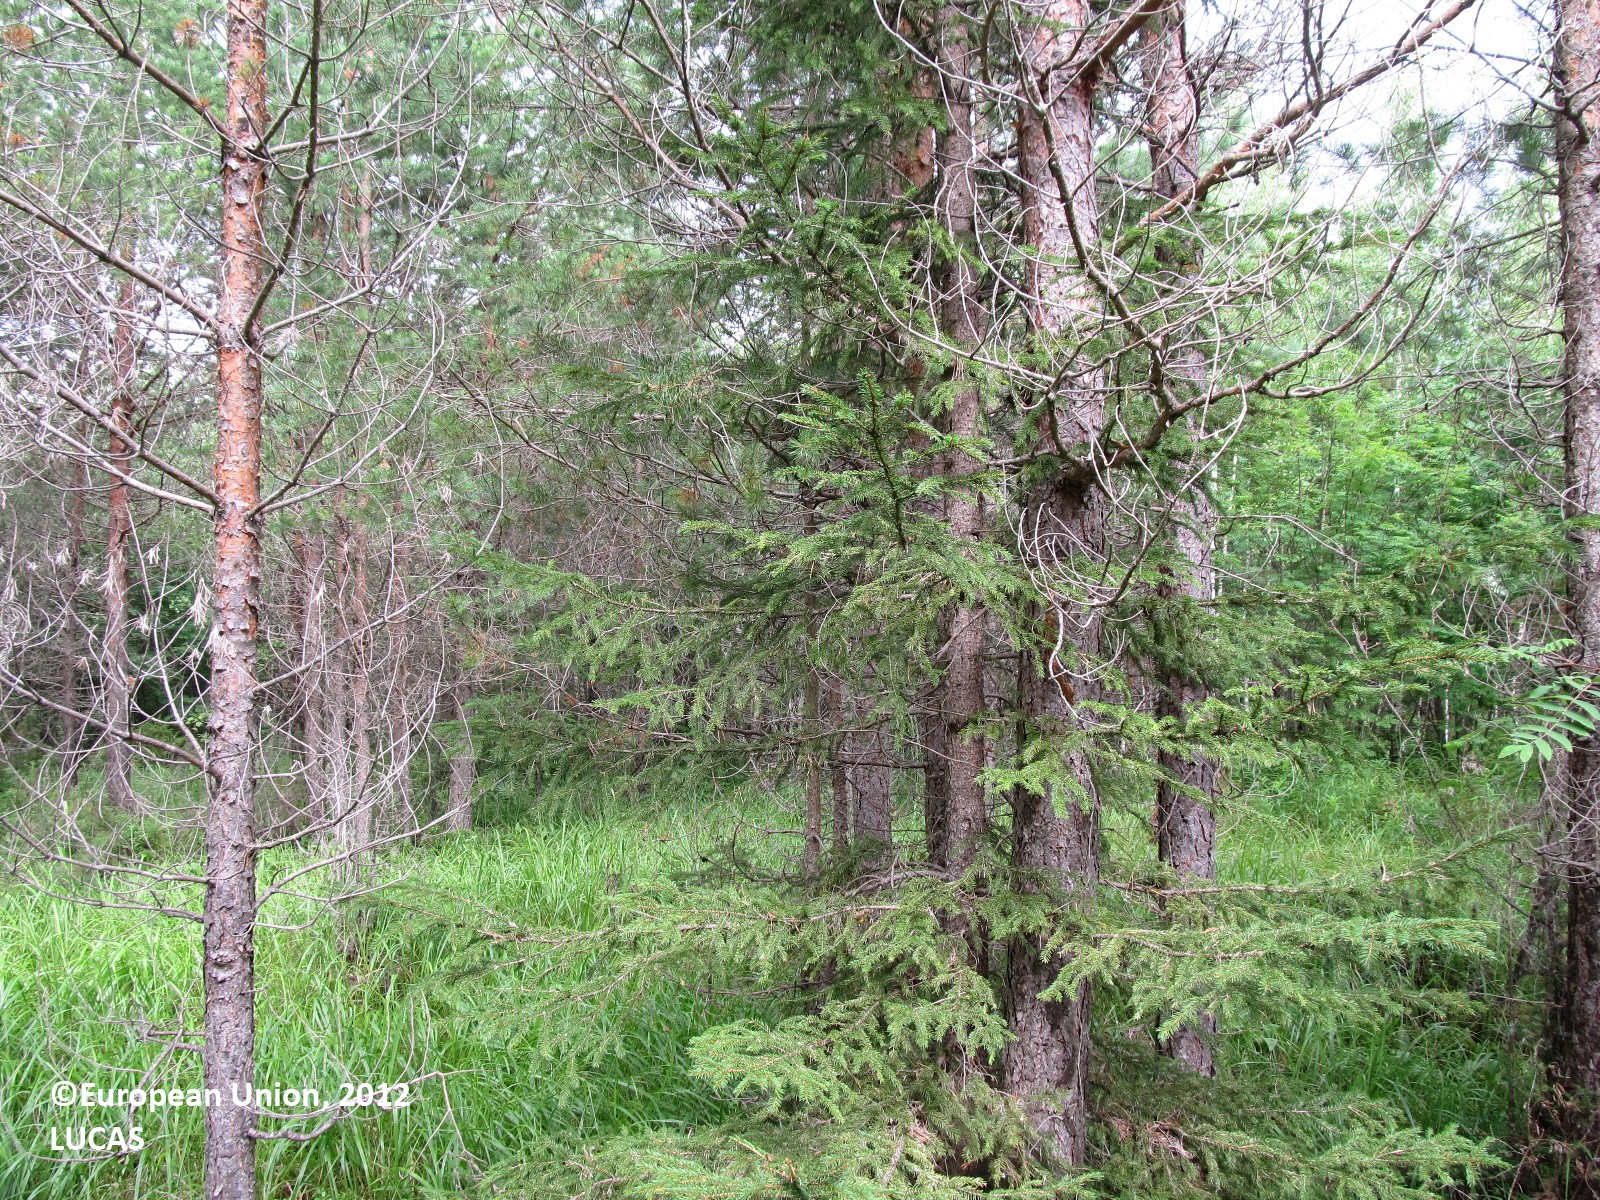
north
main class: Woodland
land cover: Pine dominated coniferous woodland
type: boreal forest
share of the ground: 25 - 50 %
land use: Forestry
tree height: > 5 m
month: July
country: FI
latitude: 61.9382
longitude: 29.0349
